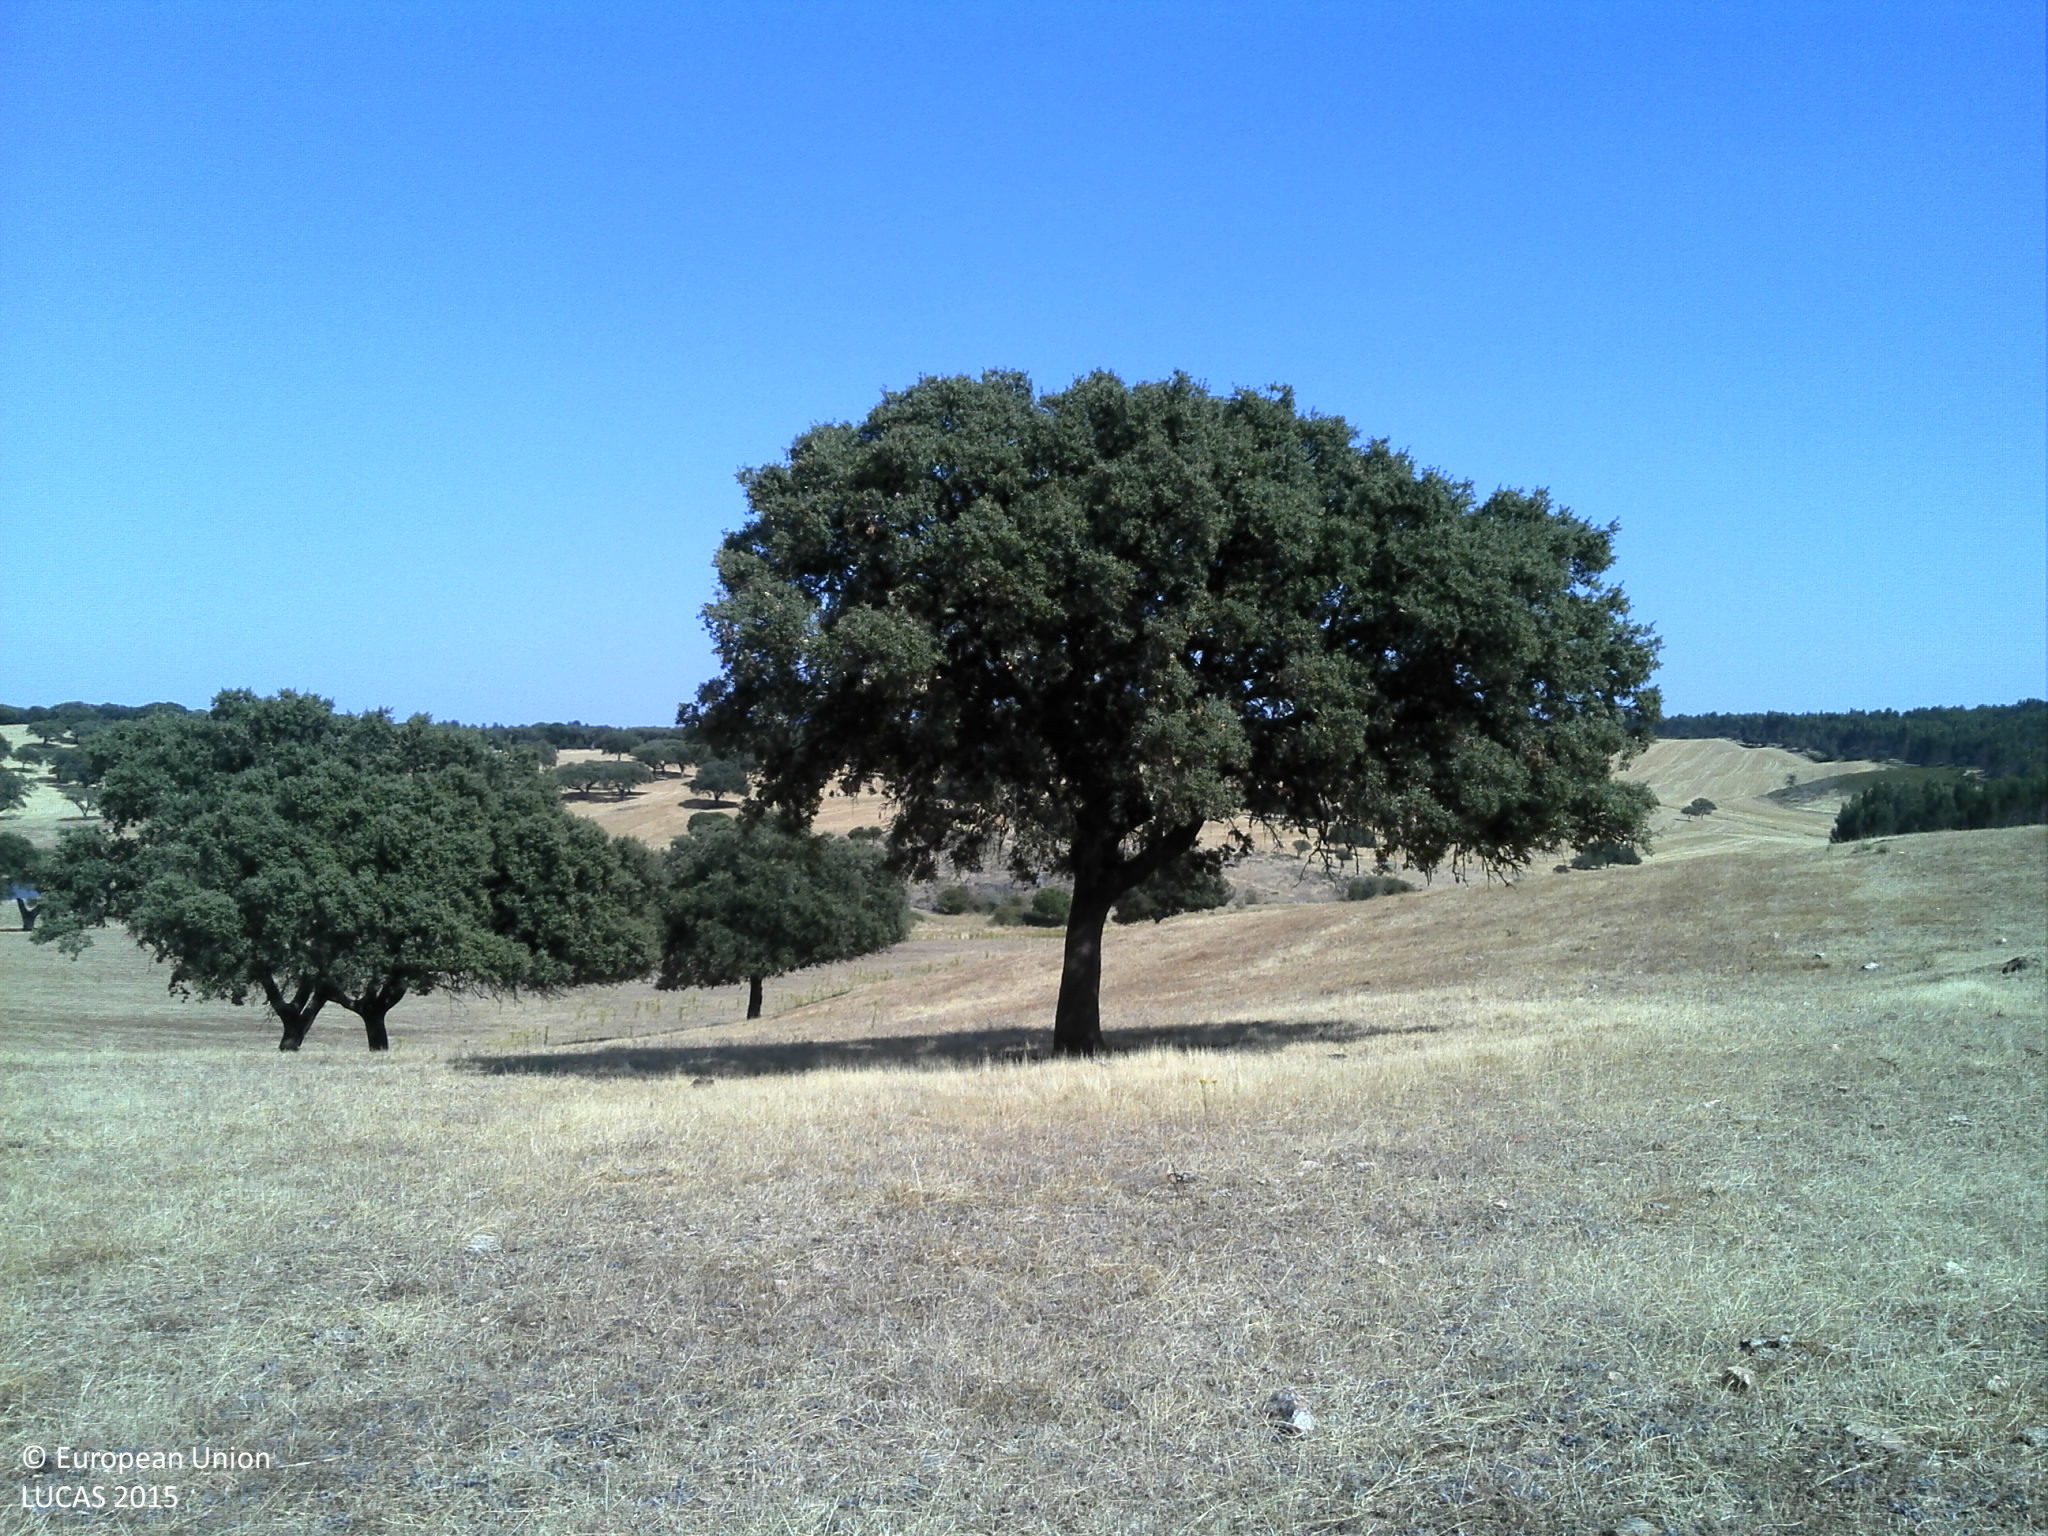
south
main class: Grassland
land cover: Grassland with sparse tree/shrub cover
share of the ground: 25 - 50 %
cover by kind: unconsolidated bare surface 50 %, herbaceous plants 45 %, broadleaved forest trees 5 %
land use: Agriculture (excluding fallow land and kitchen gardens)
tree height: > 5 m
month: July
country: PT
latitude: 38.6859
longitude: -7.4708
